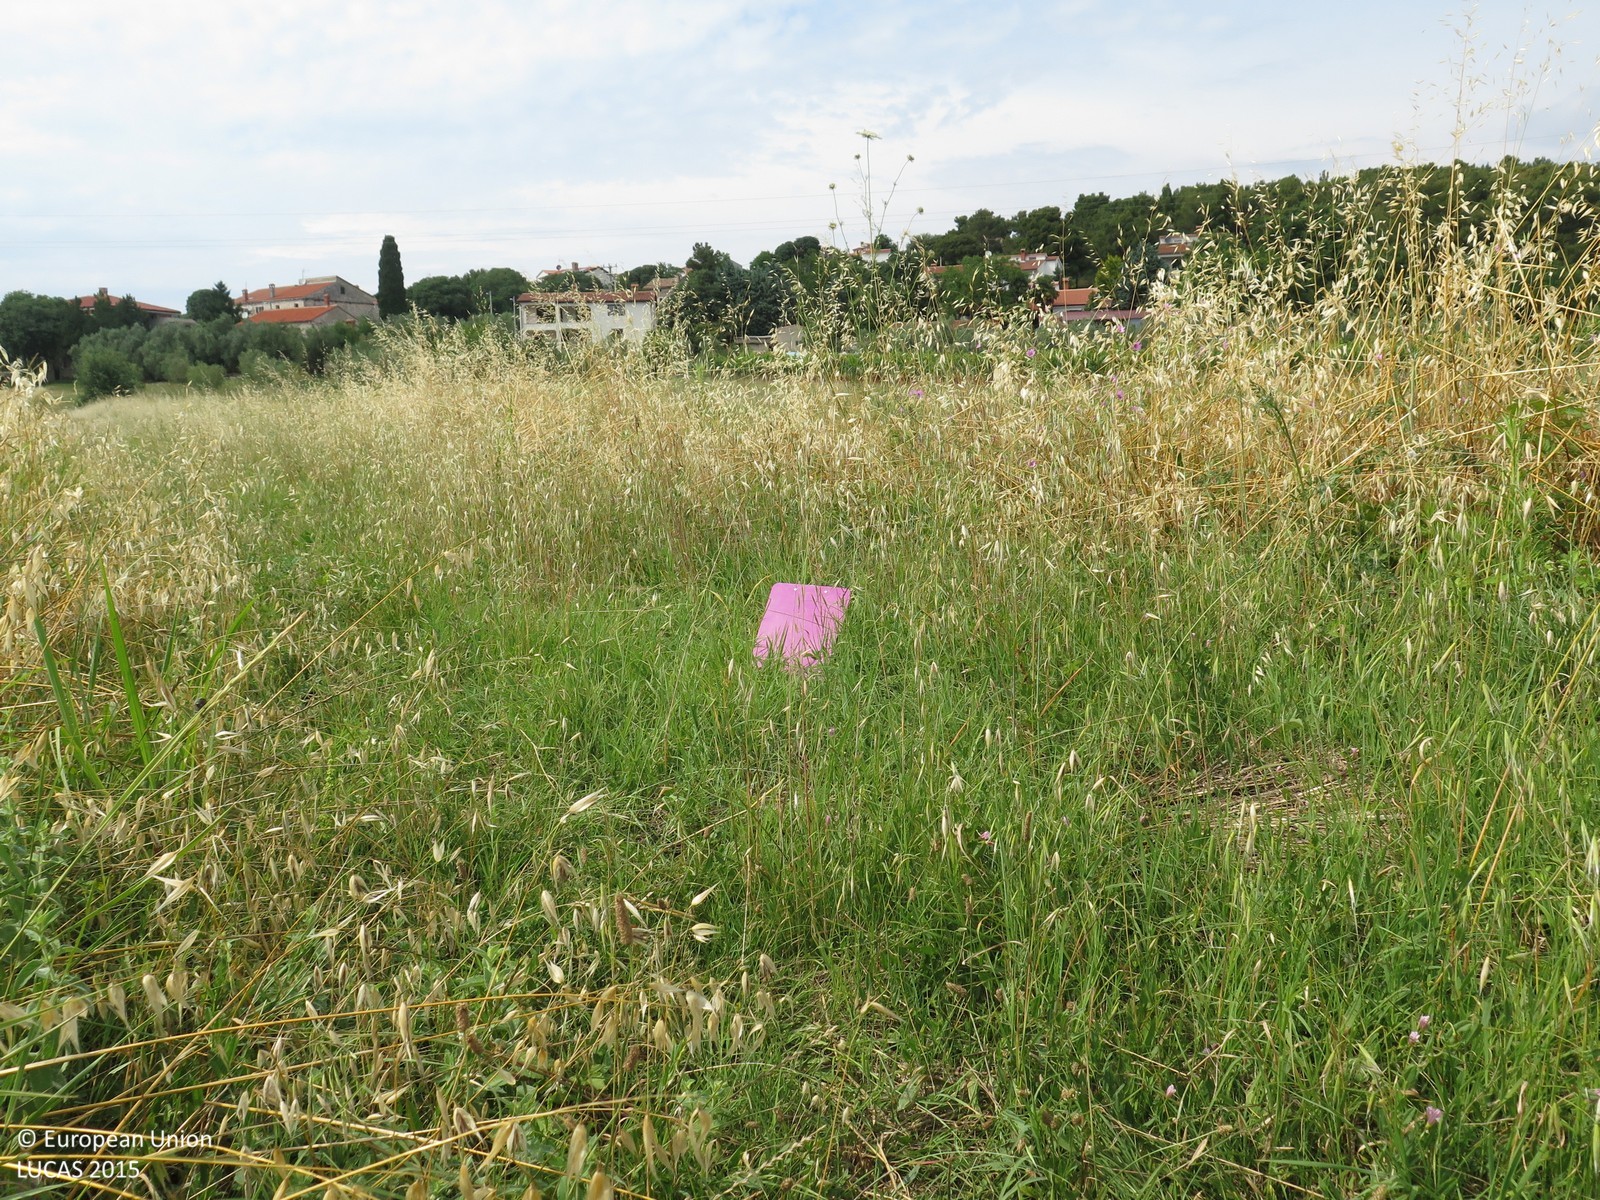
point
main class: Grassland
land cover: Grassland without tree/shrub cover
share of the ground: 25 - 50 %
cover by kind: herbaceous plants 100 %
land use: Agriculture (excluding fallow land and kitchen gardens)
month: June
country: HR
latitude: 45.1897
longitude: 13.6223
